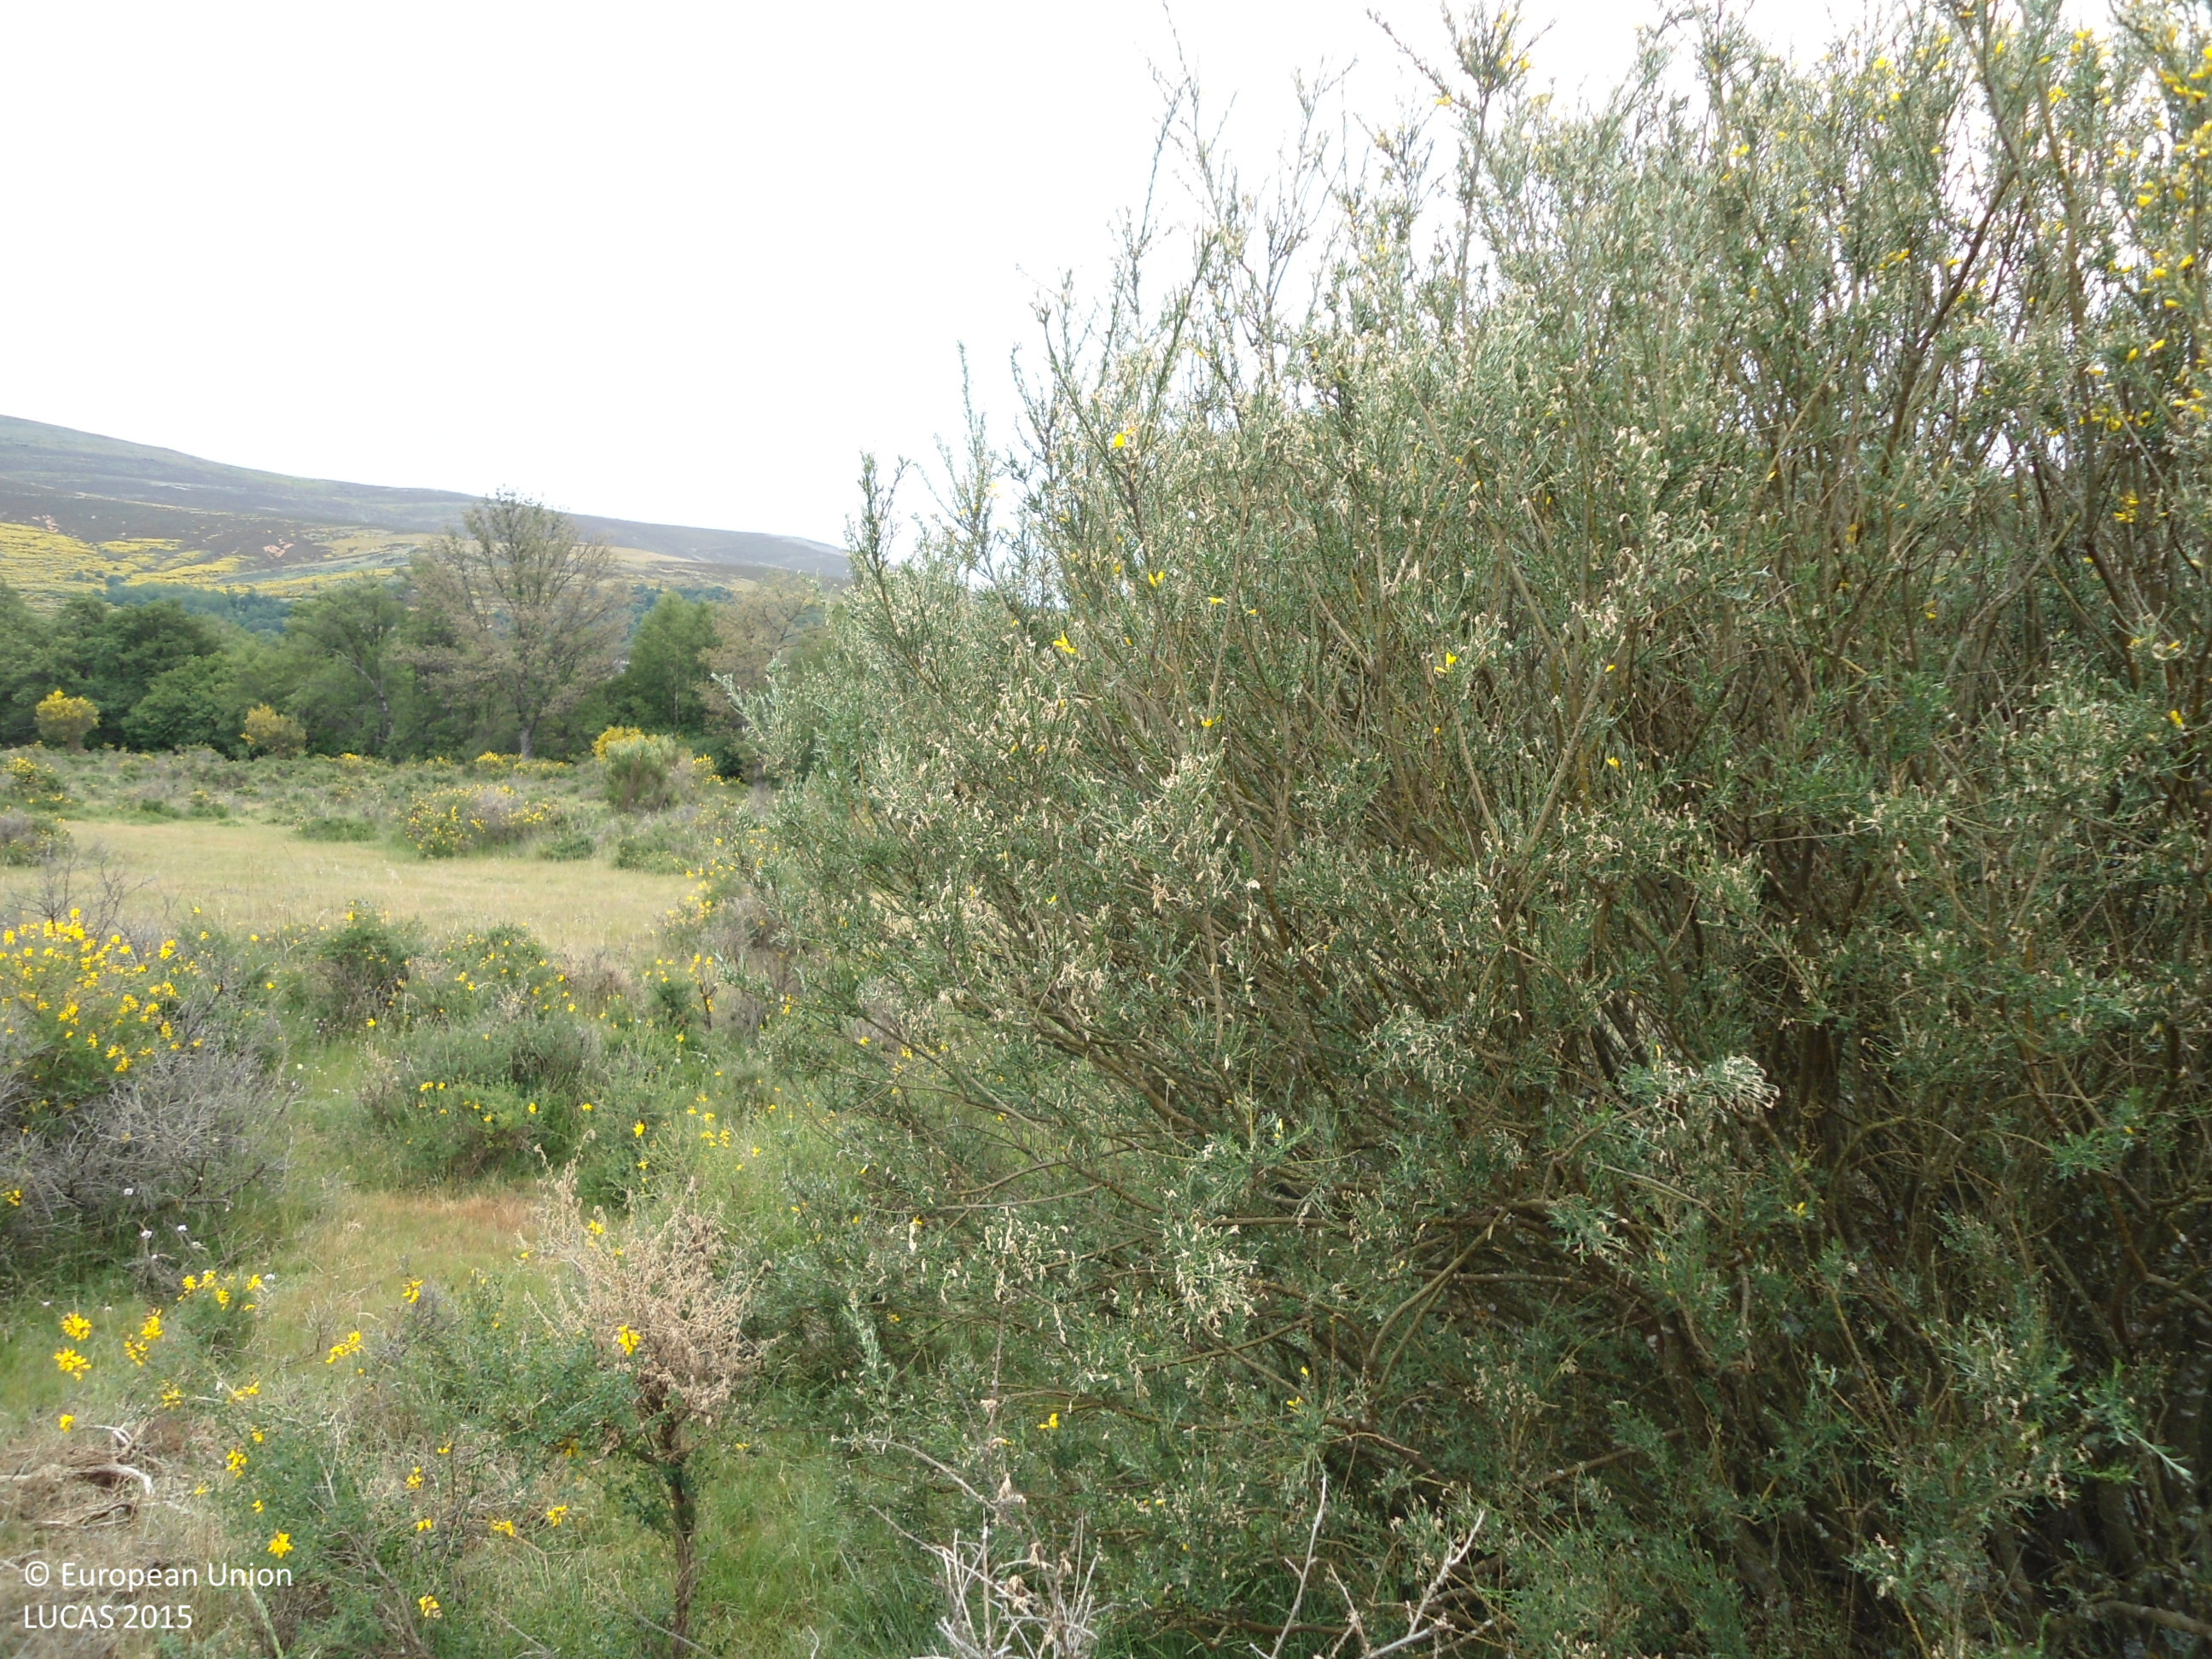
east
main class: Shrubland
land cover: Shrubland without tree cover
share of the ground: > 75 %
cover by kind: shrubs 75 %, herbaceous plants 25 %
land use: Agriculture (excluding fallow land and kitchen gardens)
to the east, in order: Shrubland without tree cover; Grassland without tree/shrub cover; Tracks; Shrubland without tree cover; Dry stone walls; Grassland without tree/shrub cover; Groves; Ditches and canals; Grassland without tree/shrub cover; Dry stone walls; Abandoned hedges; Fences; Broadleaved woodland; Rock outcrops; Rivers and streams; Rock outcrops; Shrubland without tree cover; Tracks; Shrubland with sparse tree cover; Tracks; Shrubland without tree cover; Other bare soil; Ditches and canals; Shrubland without tree cover; Rocks and stones; Shrubland without tree cover; Tracks; Shrubland without tree cover
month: June
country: ES
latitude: 42.2563
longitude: -6.4397
